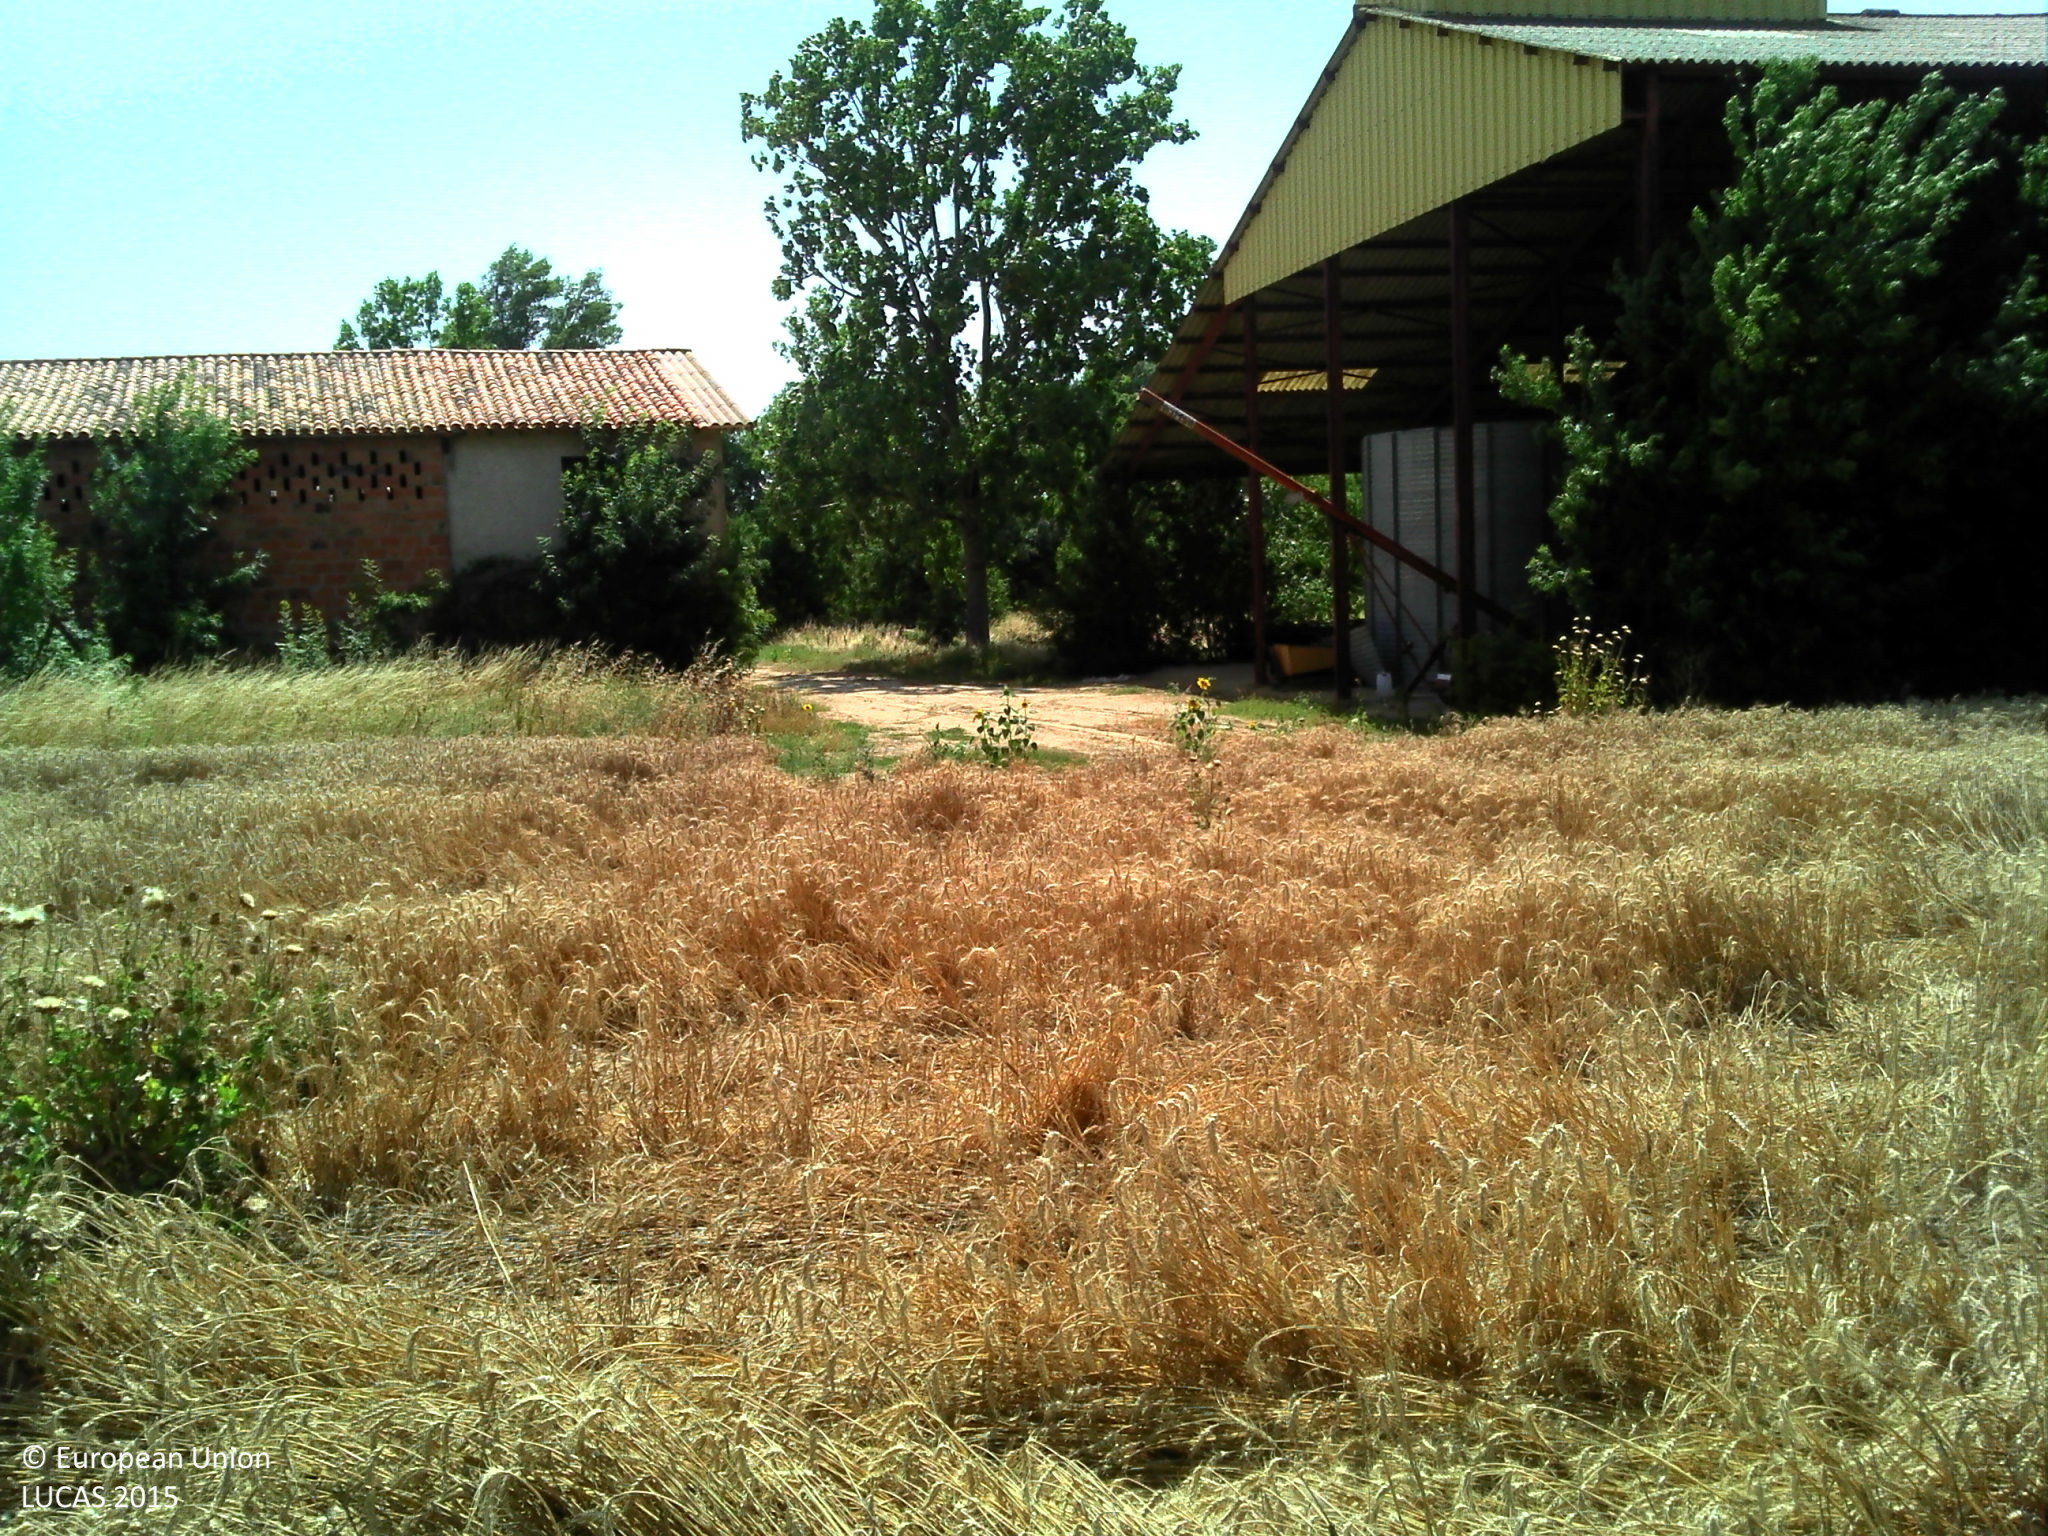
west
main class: Cropland
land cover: Common wheat
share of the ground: > 75 %
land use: Agriculture (excluding fallow land and kitchen gardens)
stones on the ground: < 10 %
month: July
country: FR
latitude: 43.5418
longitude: 1.0034
